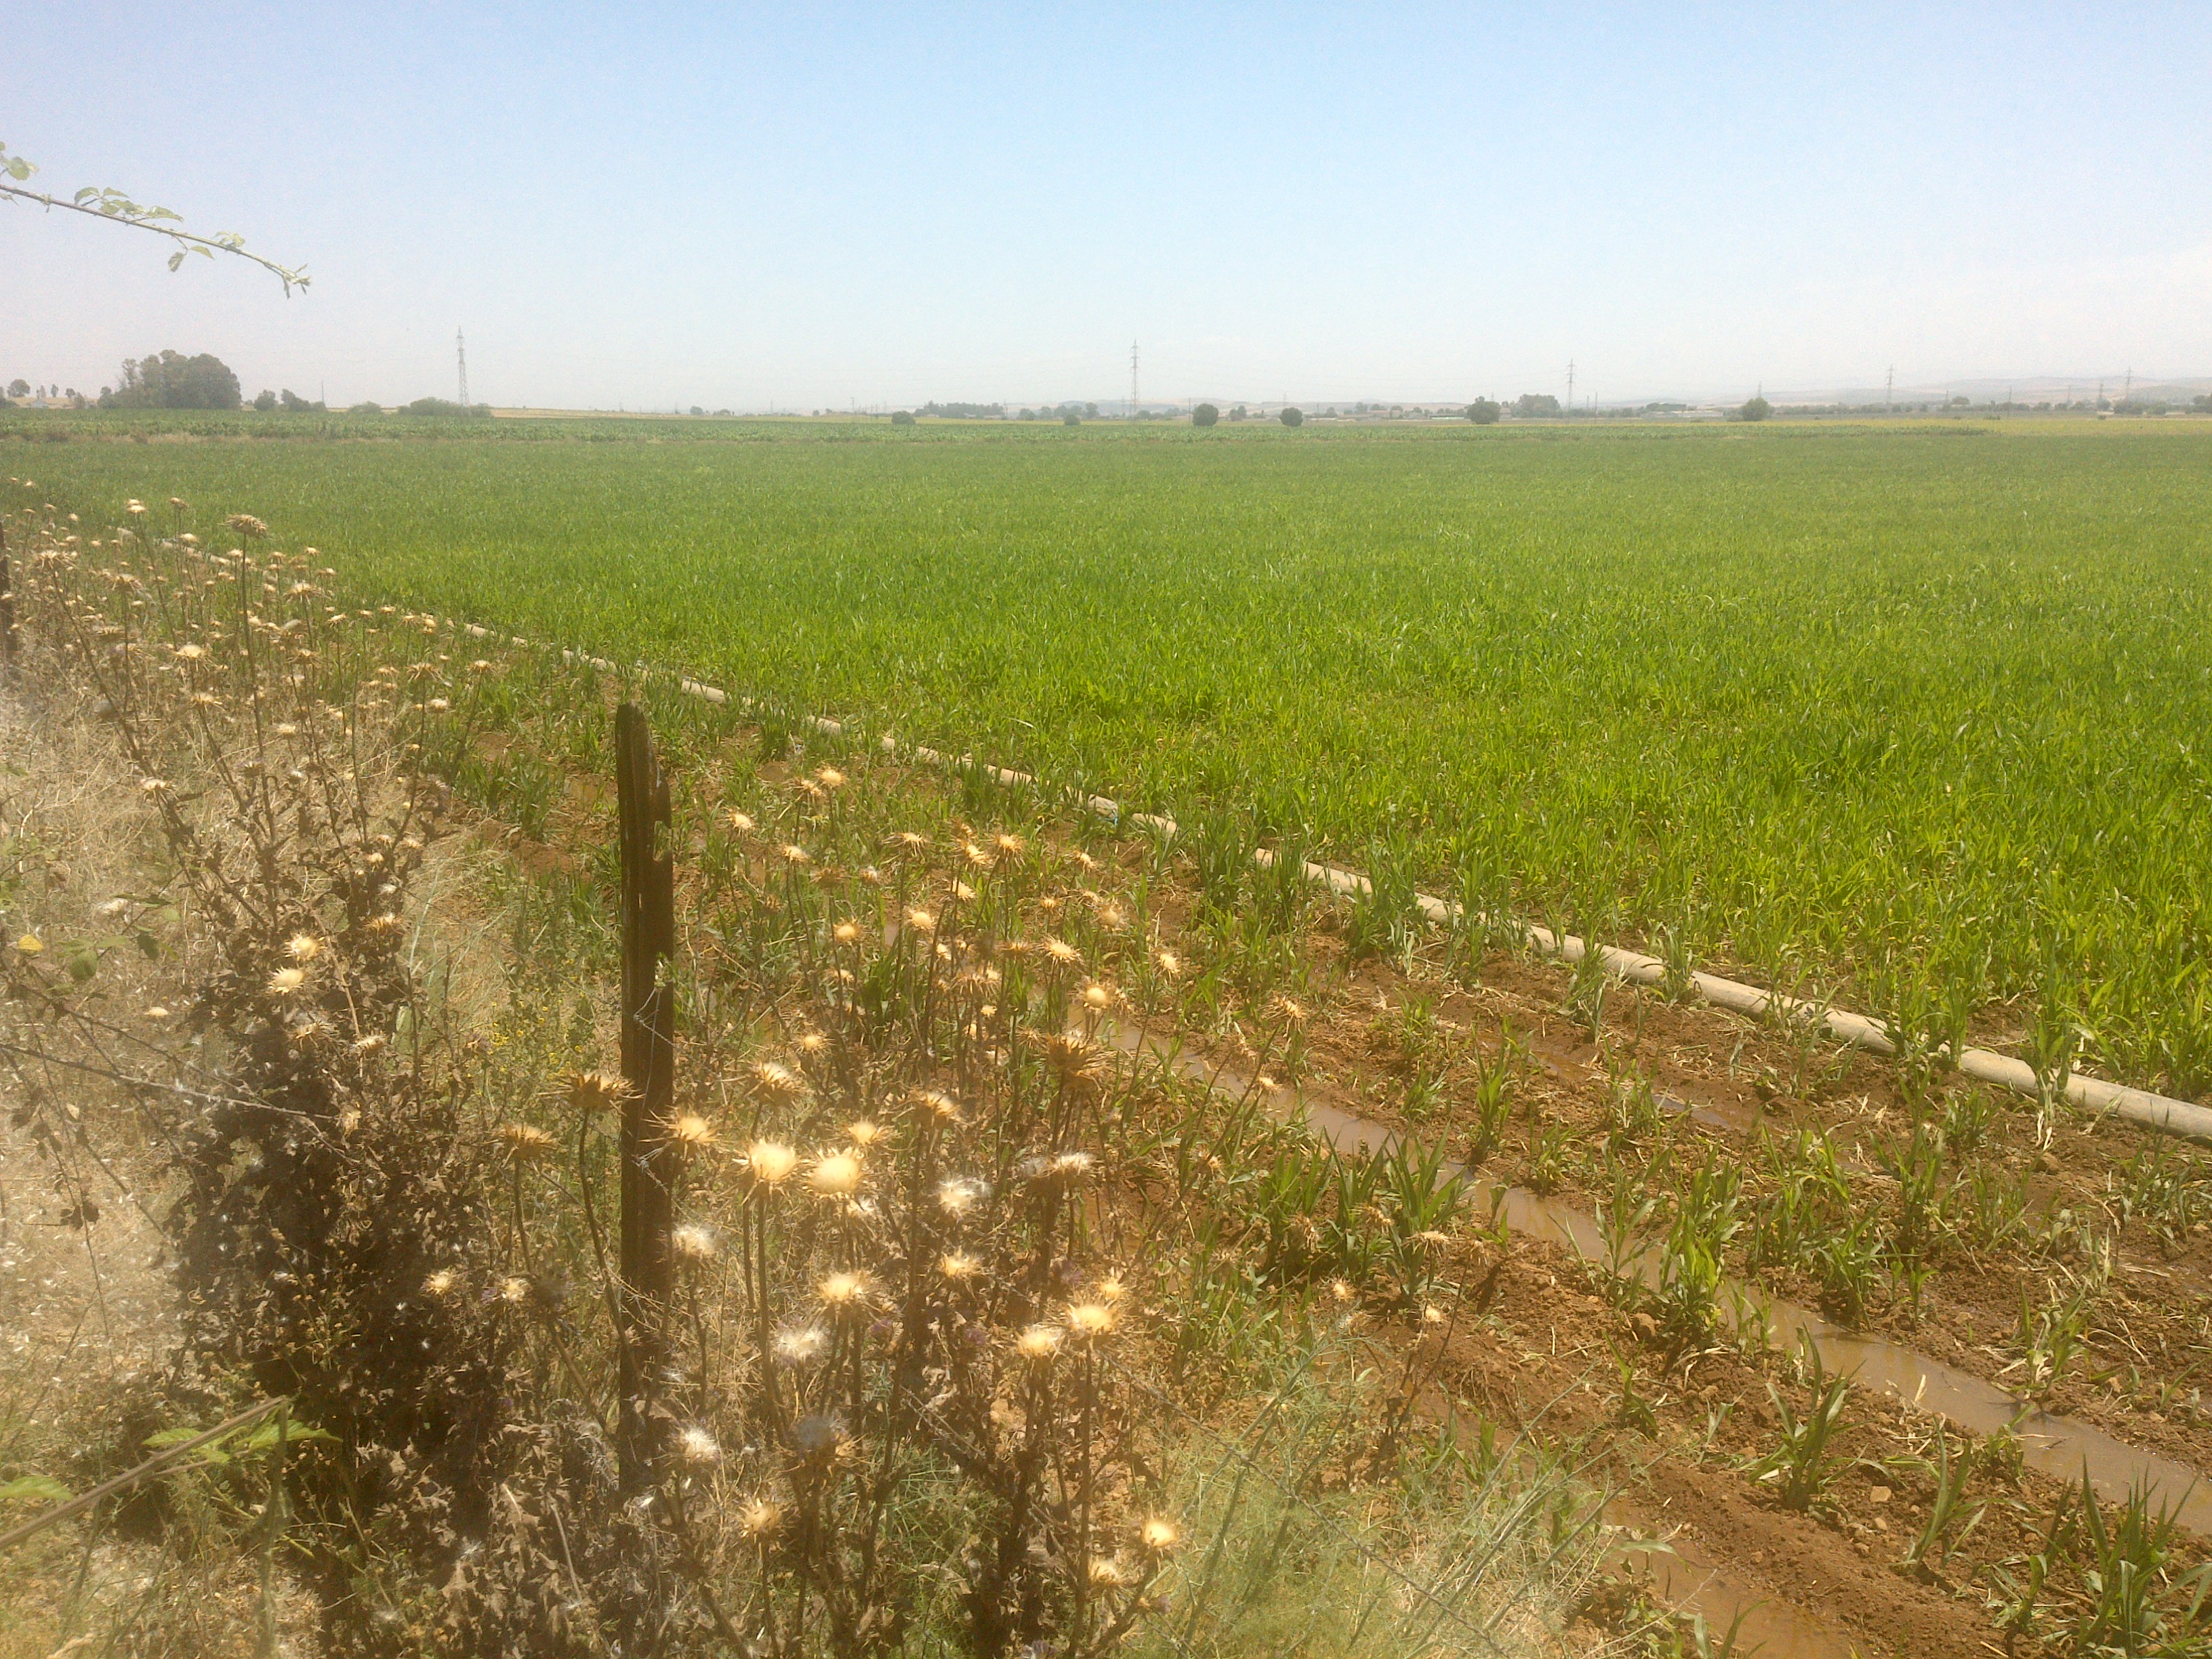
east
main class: Cropland
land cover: Maize
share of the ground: > 75 %
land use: Agriculture (excluding fallow land and kitchen gardens)
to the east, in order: Maize; Grass margins; Fences; Grass margins; Maize
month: May
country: ES
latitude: 37.8697
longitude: -4.9193
